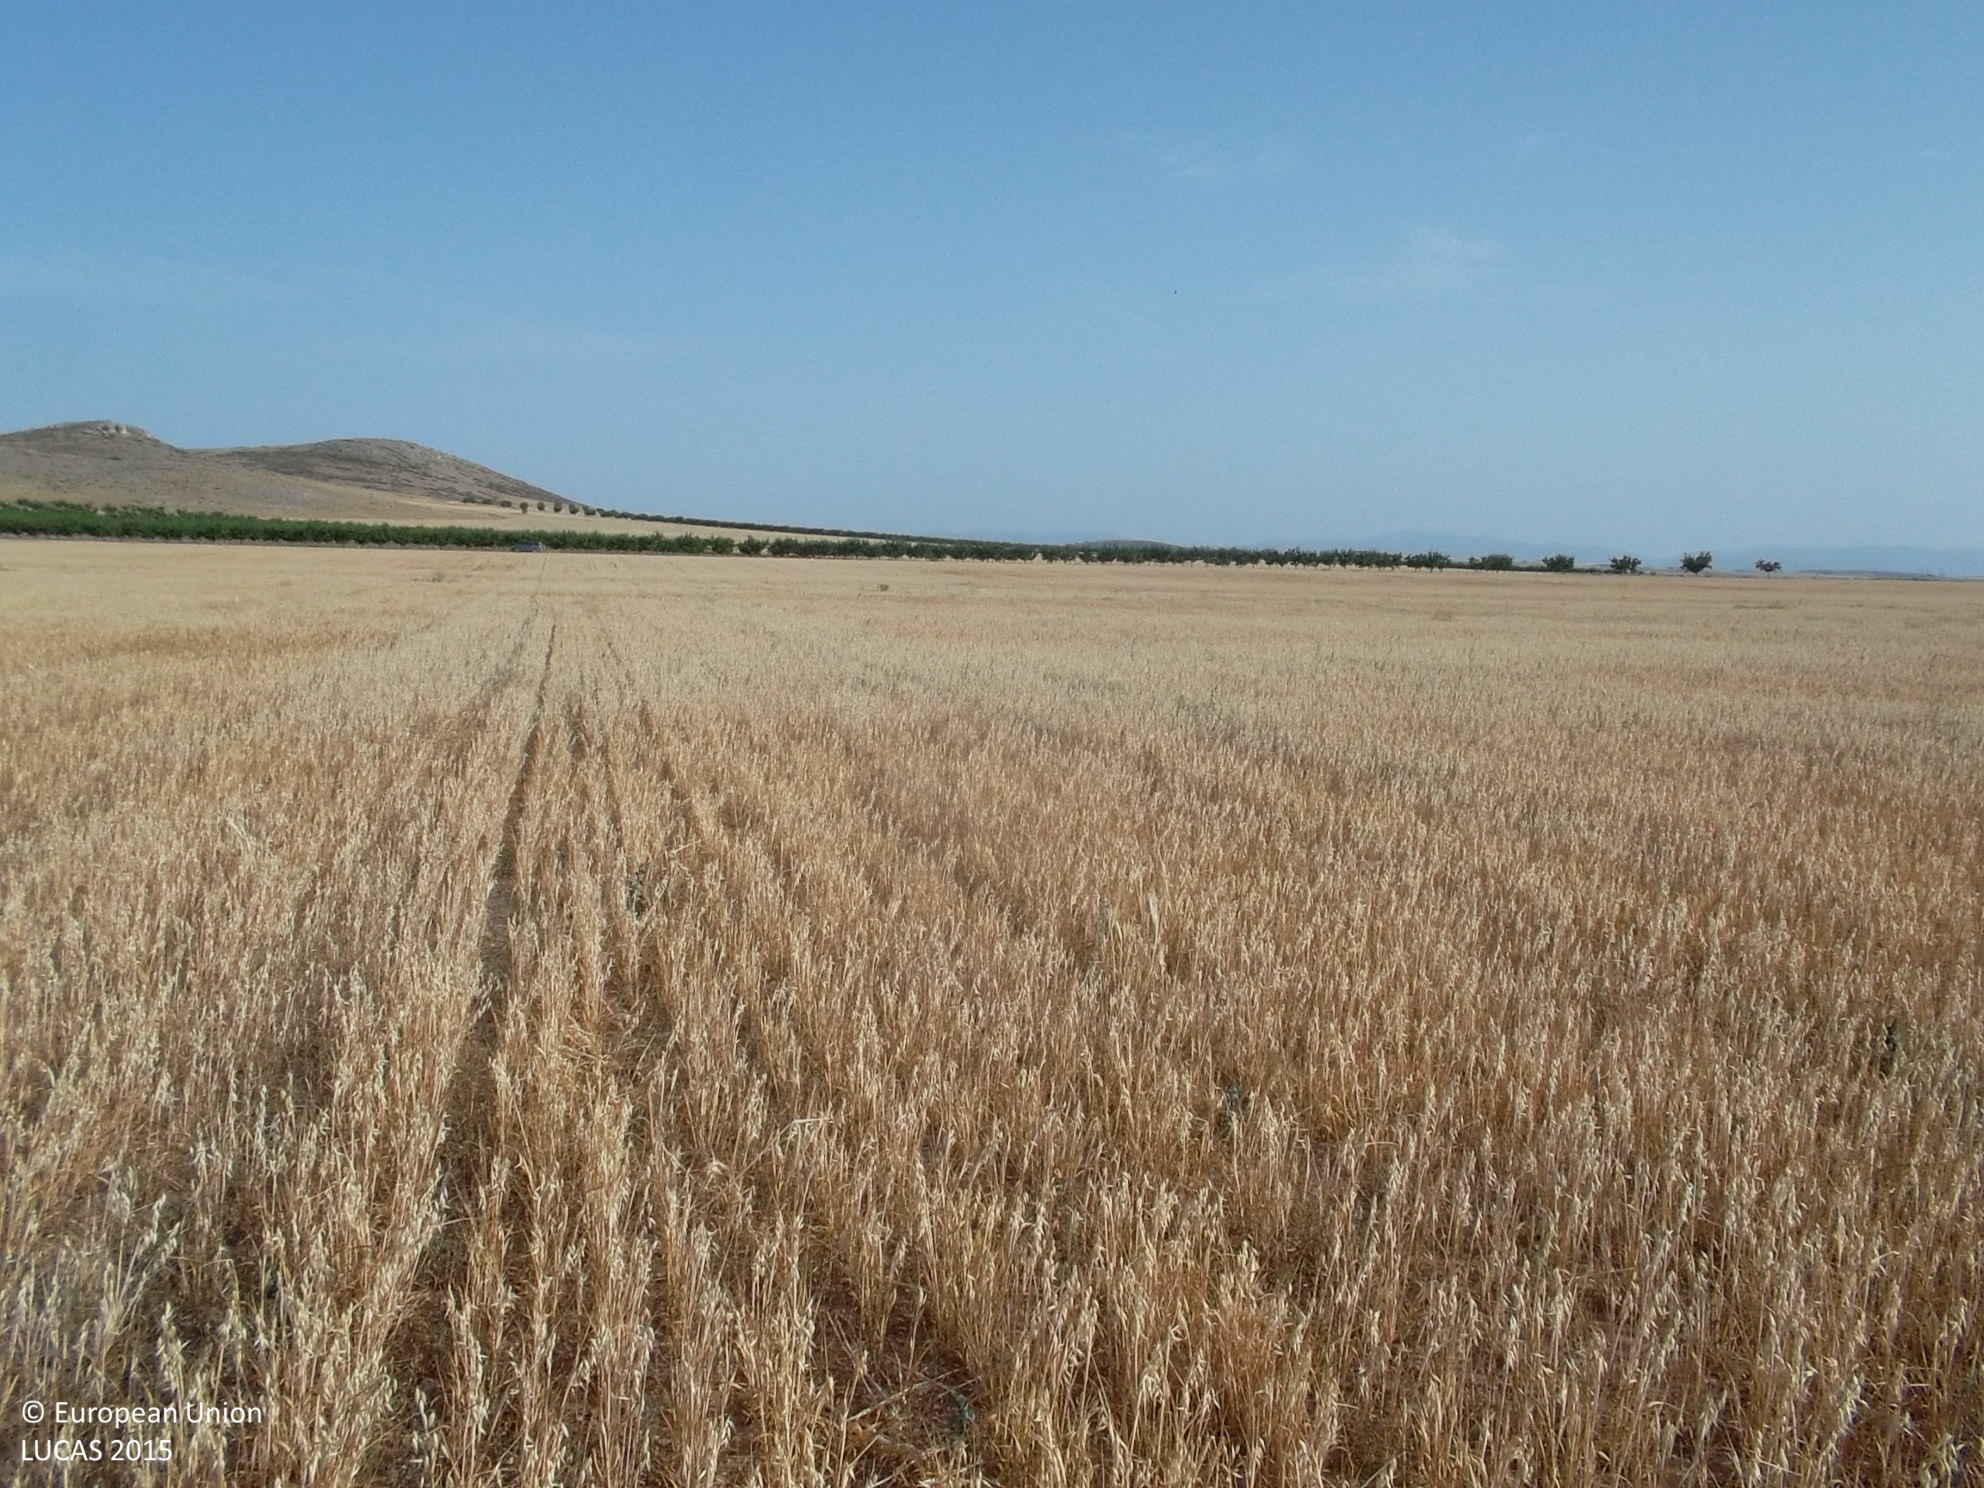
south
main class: Cropland
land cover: Oats
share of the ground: > 75 %
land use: Agriculture (excluding fallow land and kitchen gardens)
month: July
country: ES
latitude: 37.8918
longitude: -2.3502
